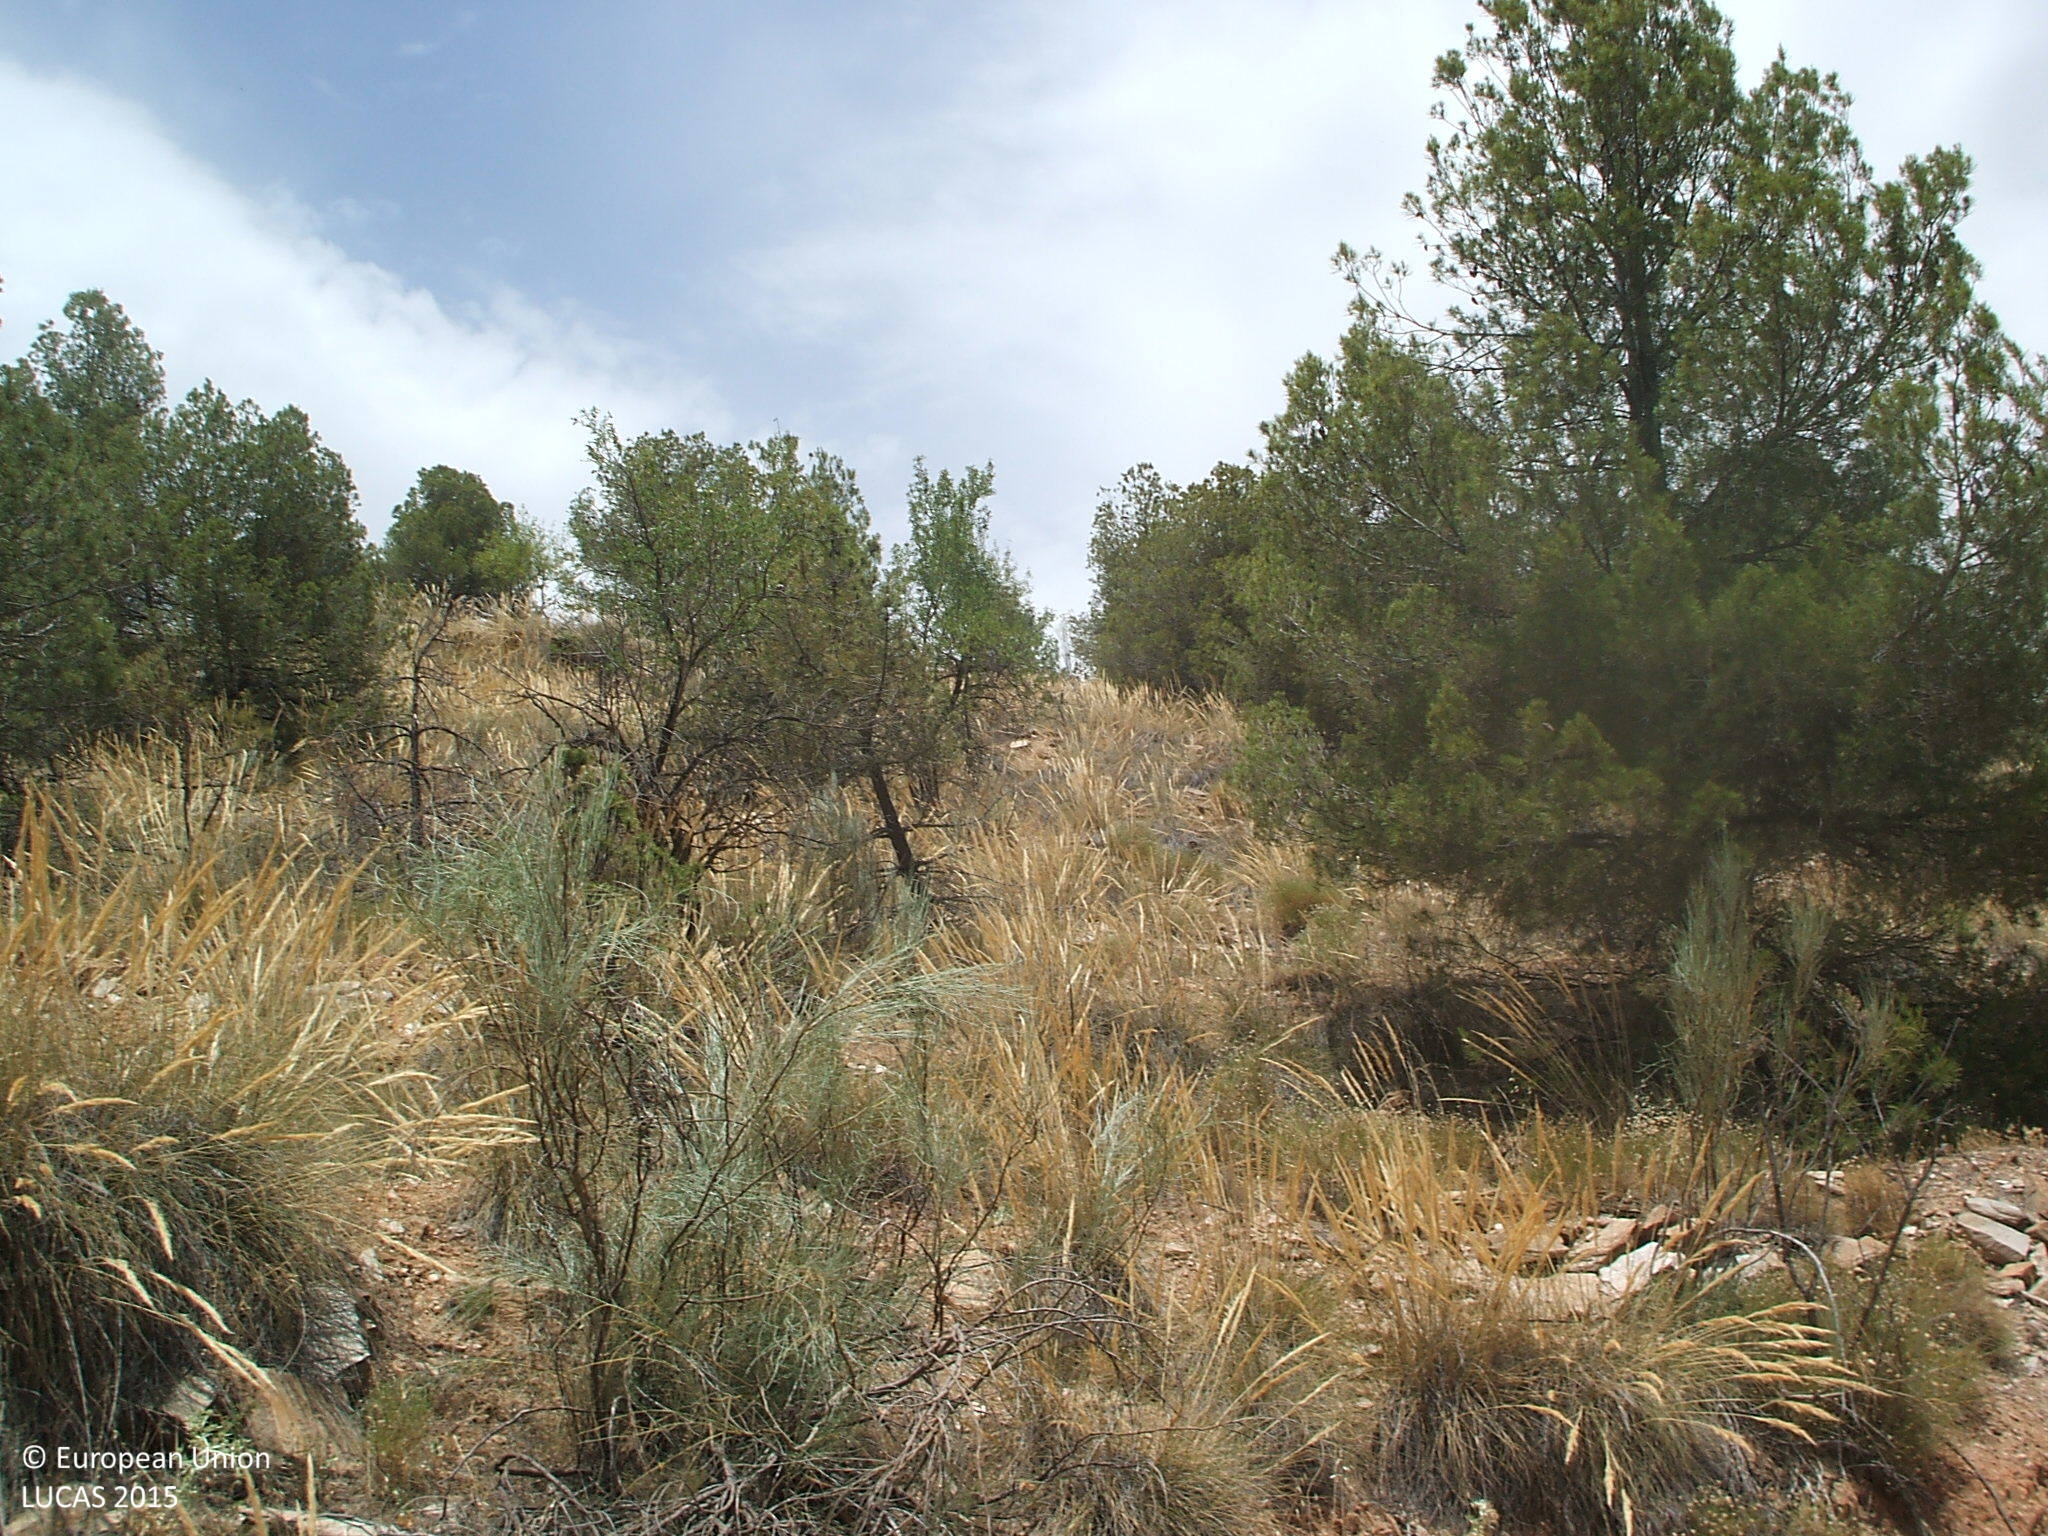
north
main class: Woodland
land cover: Pine dominated coniferous woodland
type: coniferous forest of the mediterranean region
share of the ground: 50 - 75 %
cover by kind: coniferous forest trees 60 %, herbaceous plants 20 %, consolidated bare surface 20 %
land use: Semi-natural and natural areas not in use
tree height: > 5 m
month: July
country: ES
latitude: 37.3199
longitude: -2.6561
